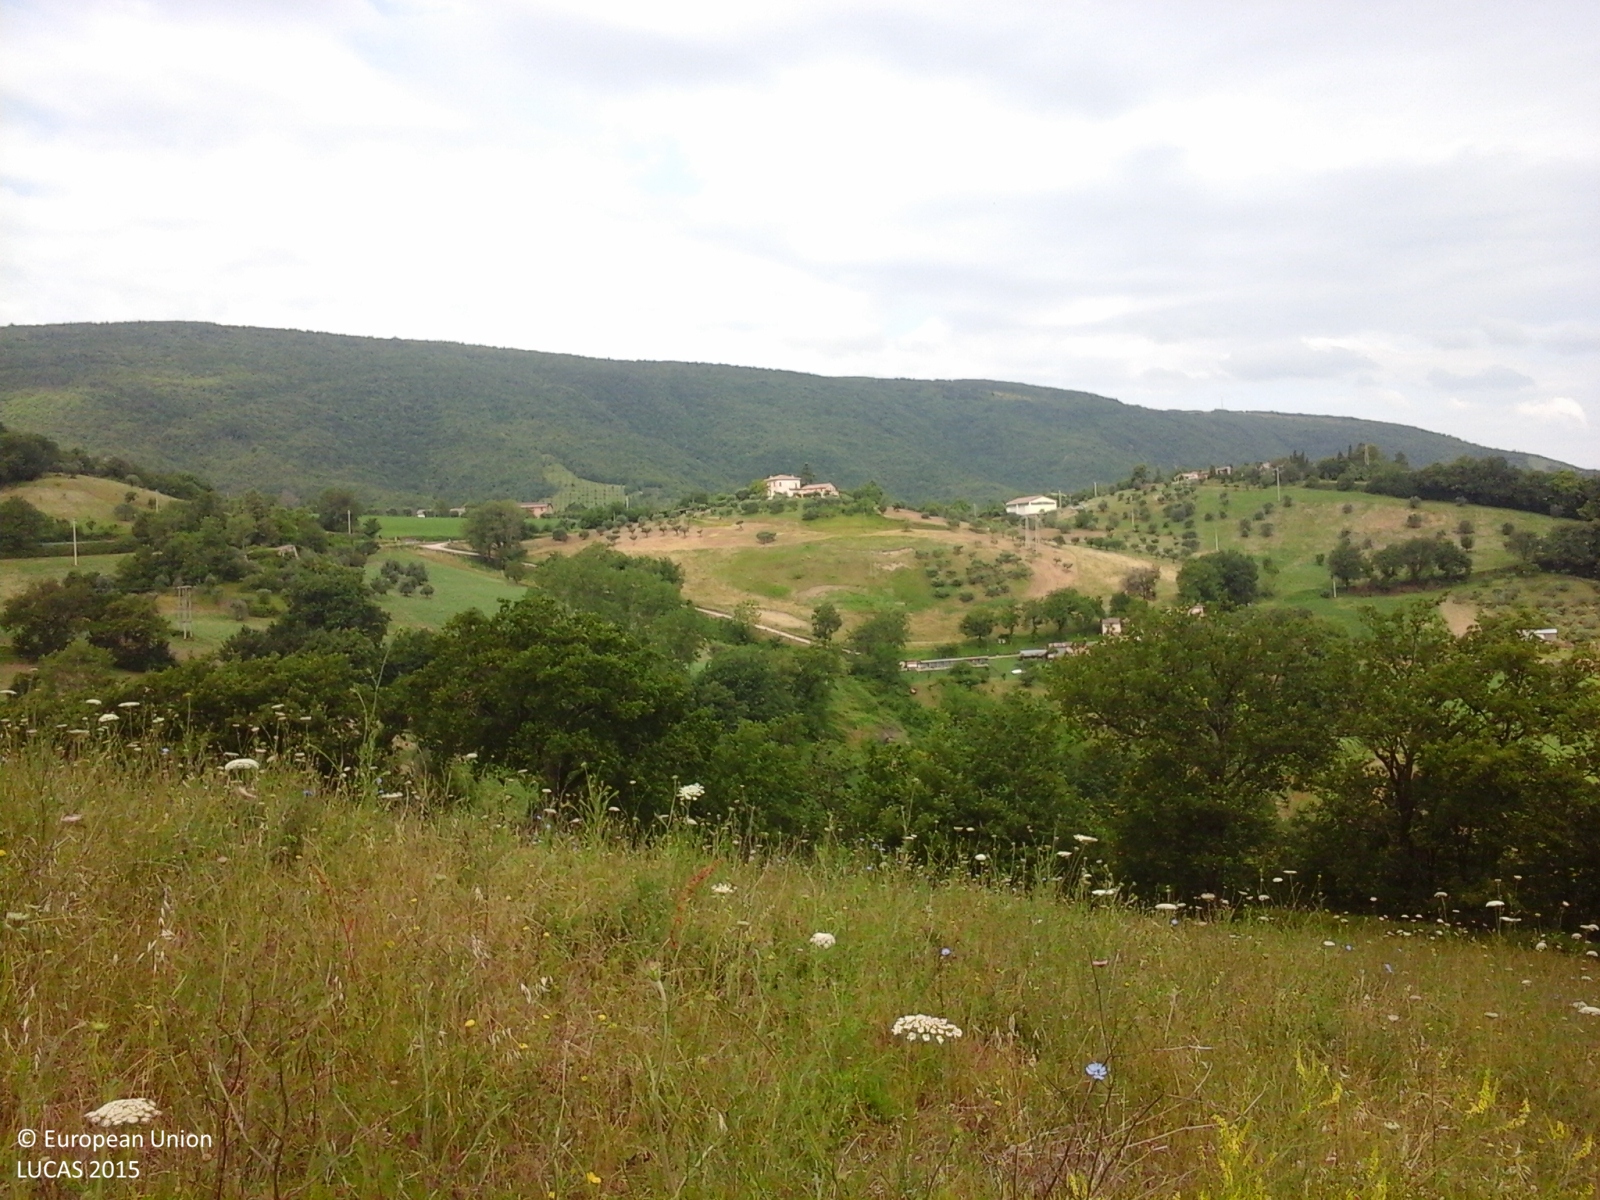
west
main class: Grassland
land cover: Spontaneously vegetated surfaces
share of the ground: > 75 %
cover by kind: herbaceous plants 95 %, shrubs 5 %
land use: Agriculture (excluding fallow land and kitchen gardens)
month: June
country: IT
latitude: 43.1997
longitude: 13.2034
